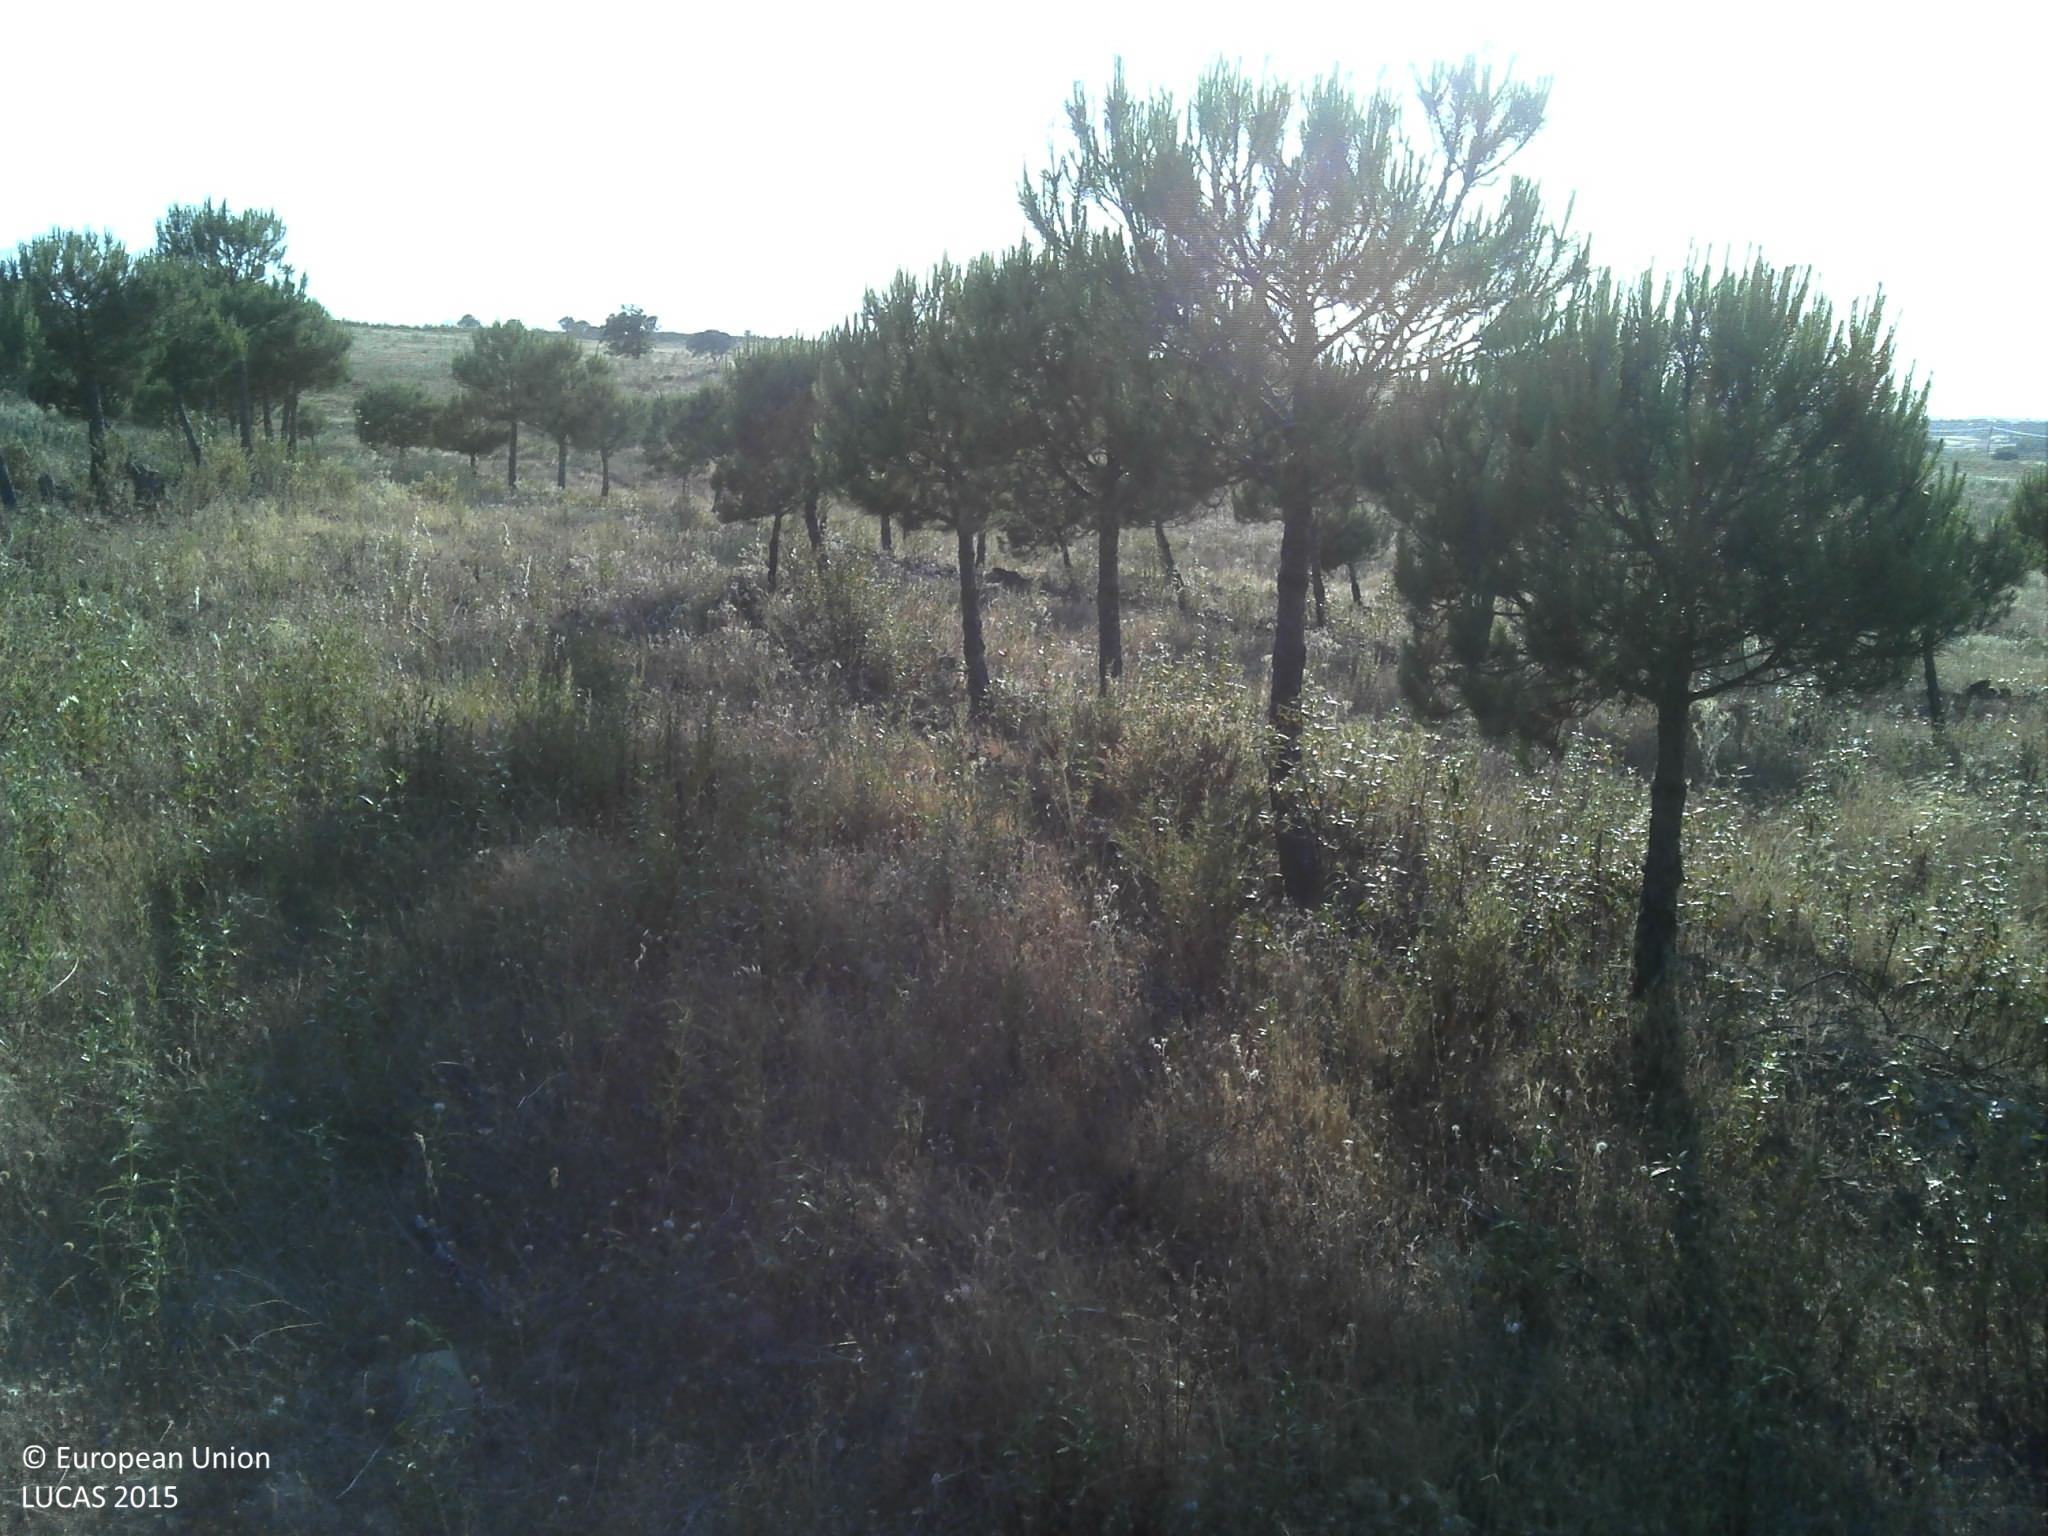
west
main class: Woodland
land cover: Pine dominated coniferous woodland
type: coniferous forest of the mediterranean region
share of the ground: 10 - 25 %
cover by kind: herbaceous plants 50 %, coniferous forest trees 25 %, shrubs 25 %
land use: Forestry
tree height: < 5 m
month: May
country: PT
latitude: 37.4334
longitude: -7.7453
